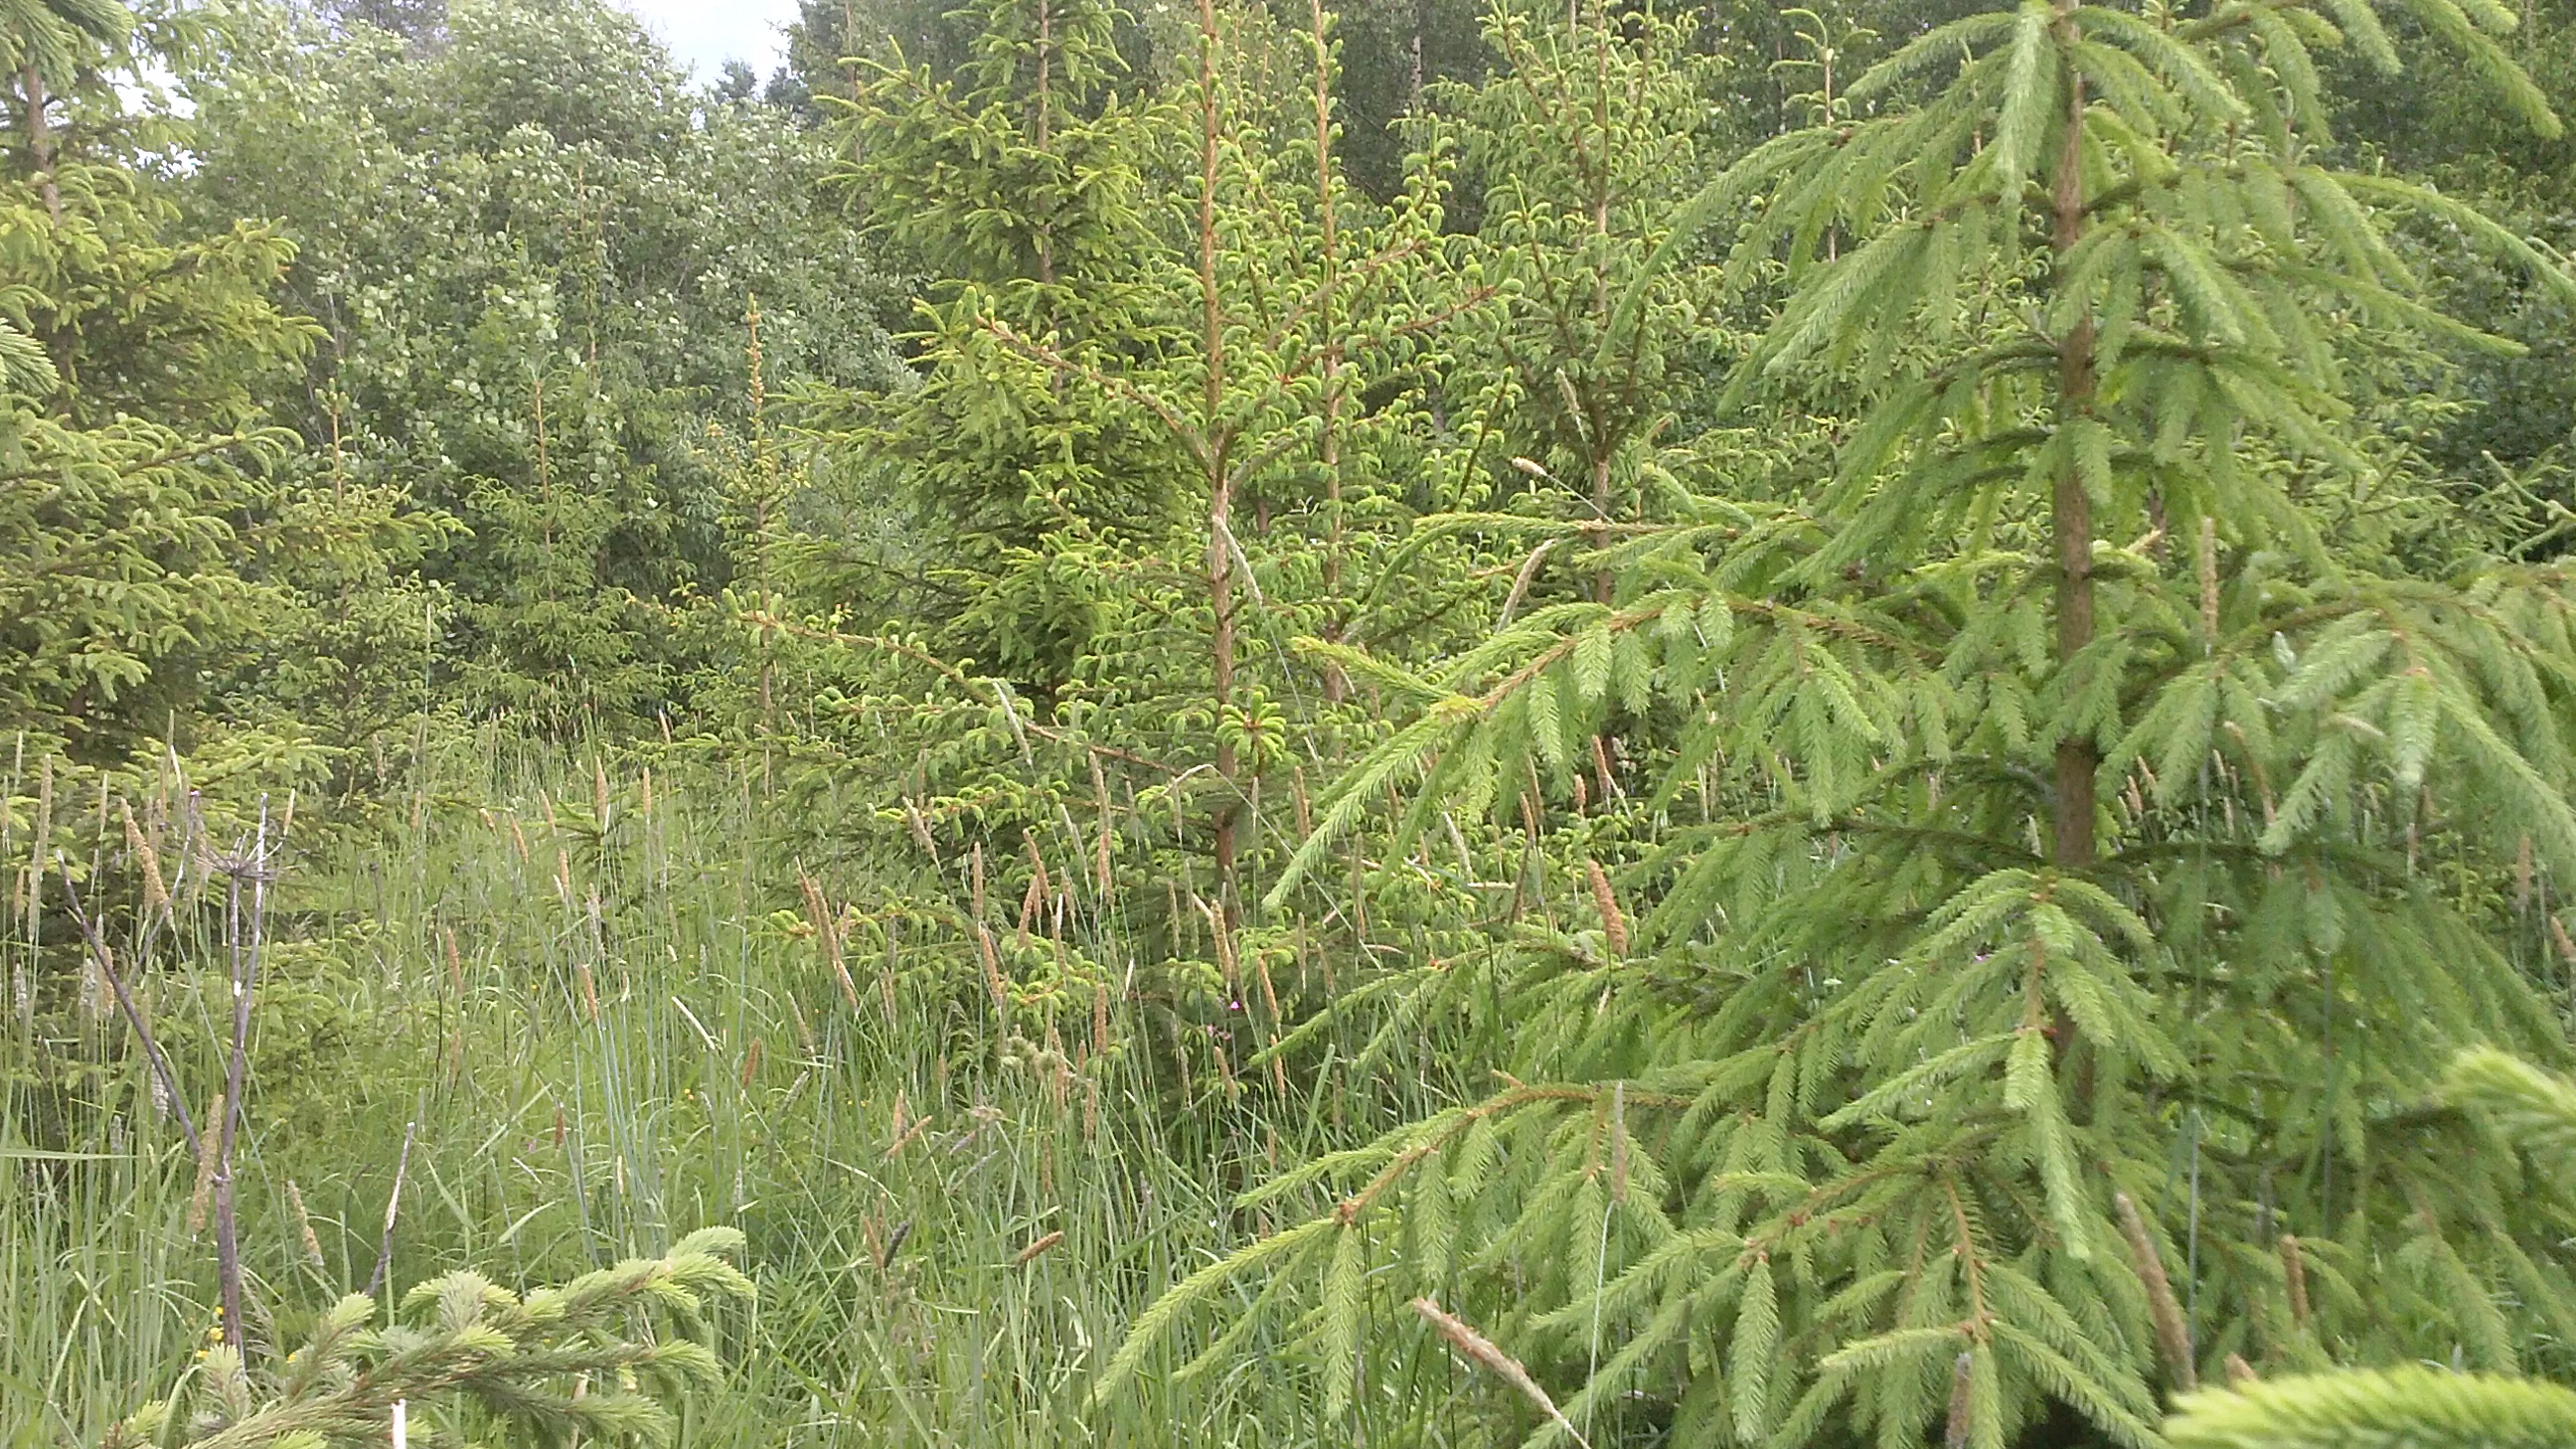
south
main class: Woodland
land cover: Spruce dominated coniferous woodland
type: hemiboreal forest and nemoral coniferous forest and mixed broadleaved-coniferous forest
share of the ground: > 75 %
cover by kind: coniferous forest trees 80 %, herbaceous plants 20 %
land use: Forestry
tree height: < 5 m
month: June
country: LV
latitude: 56.4356
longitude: 27.4499
